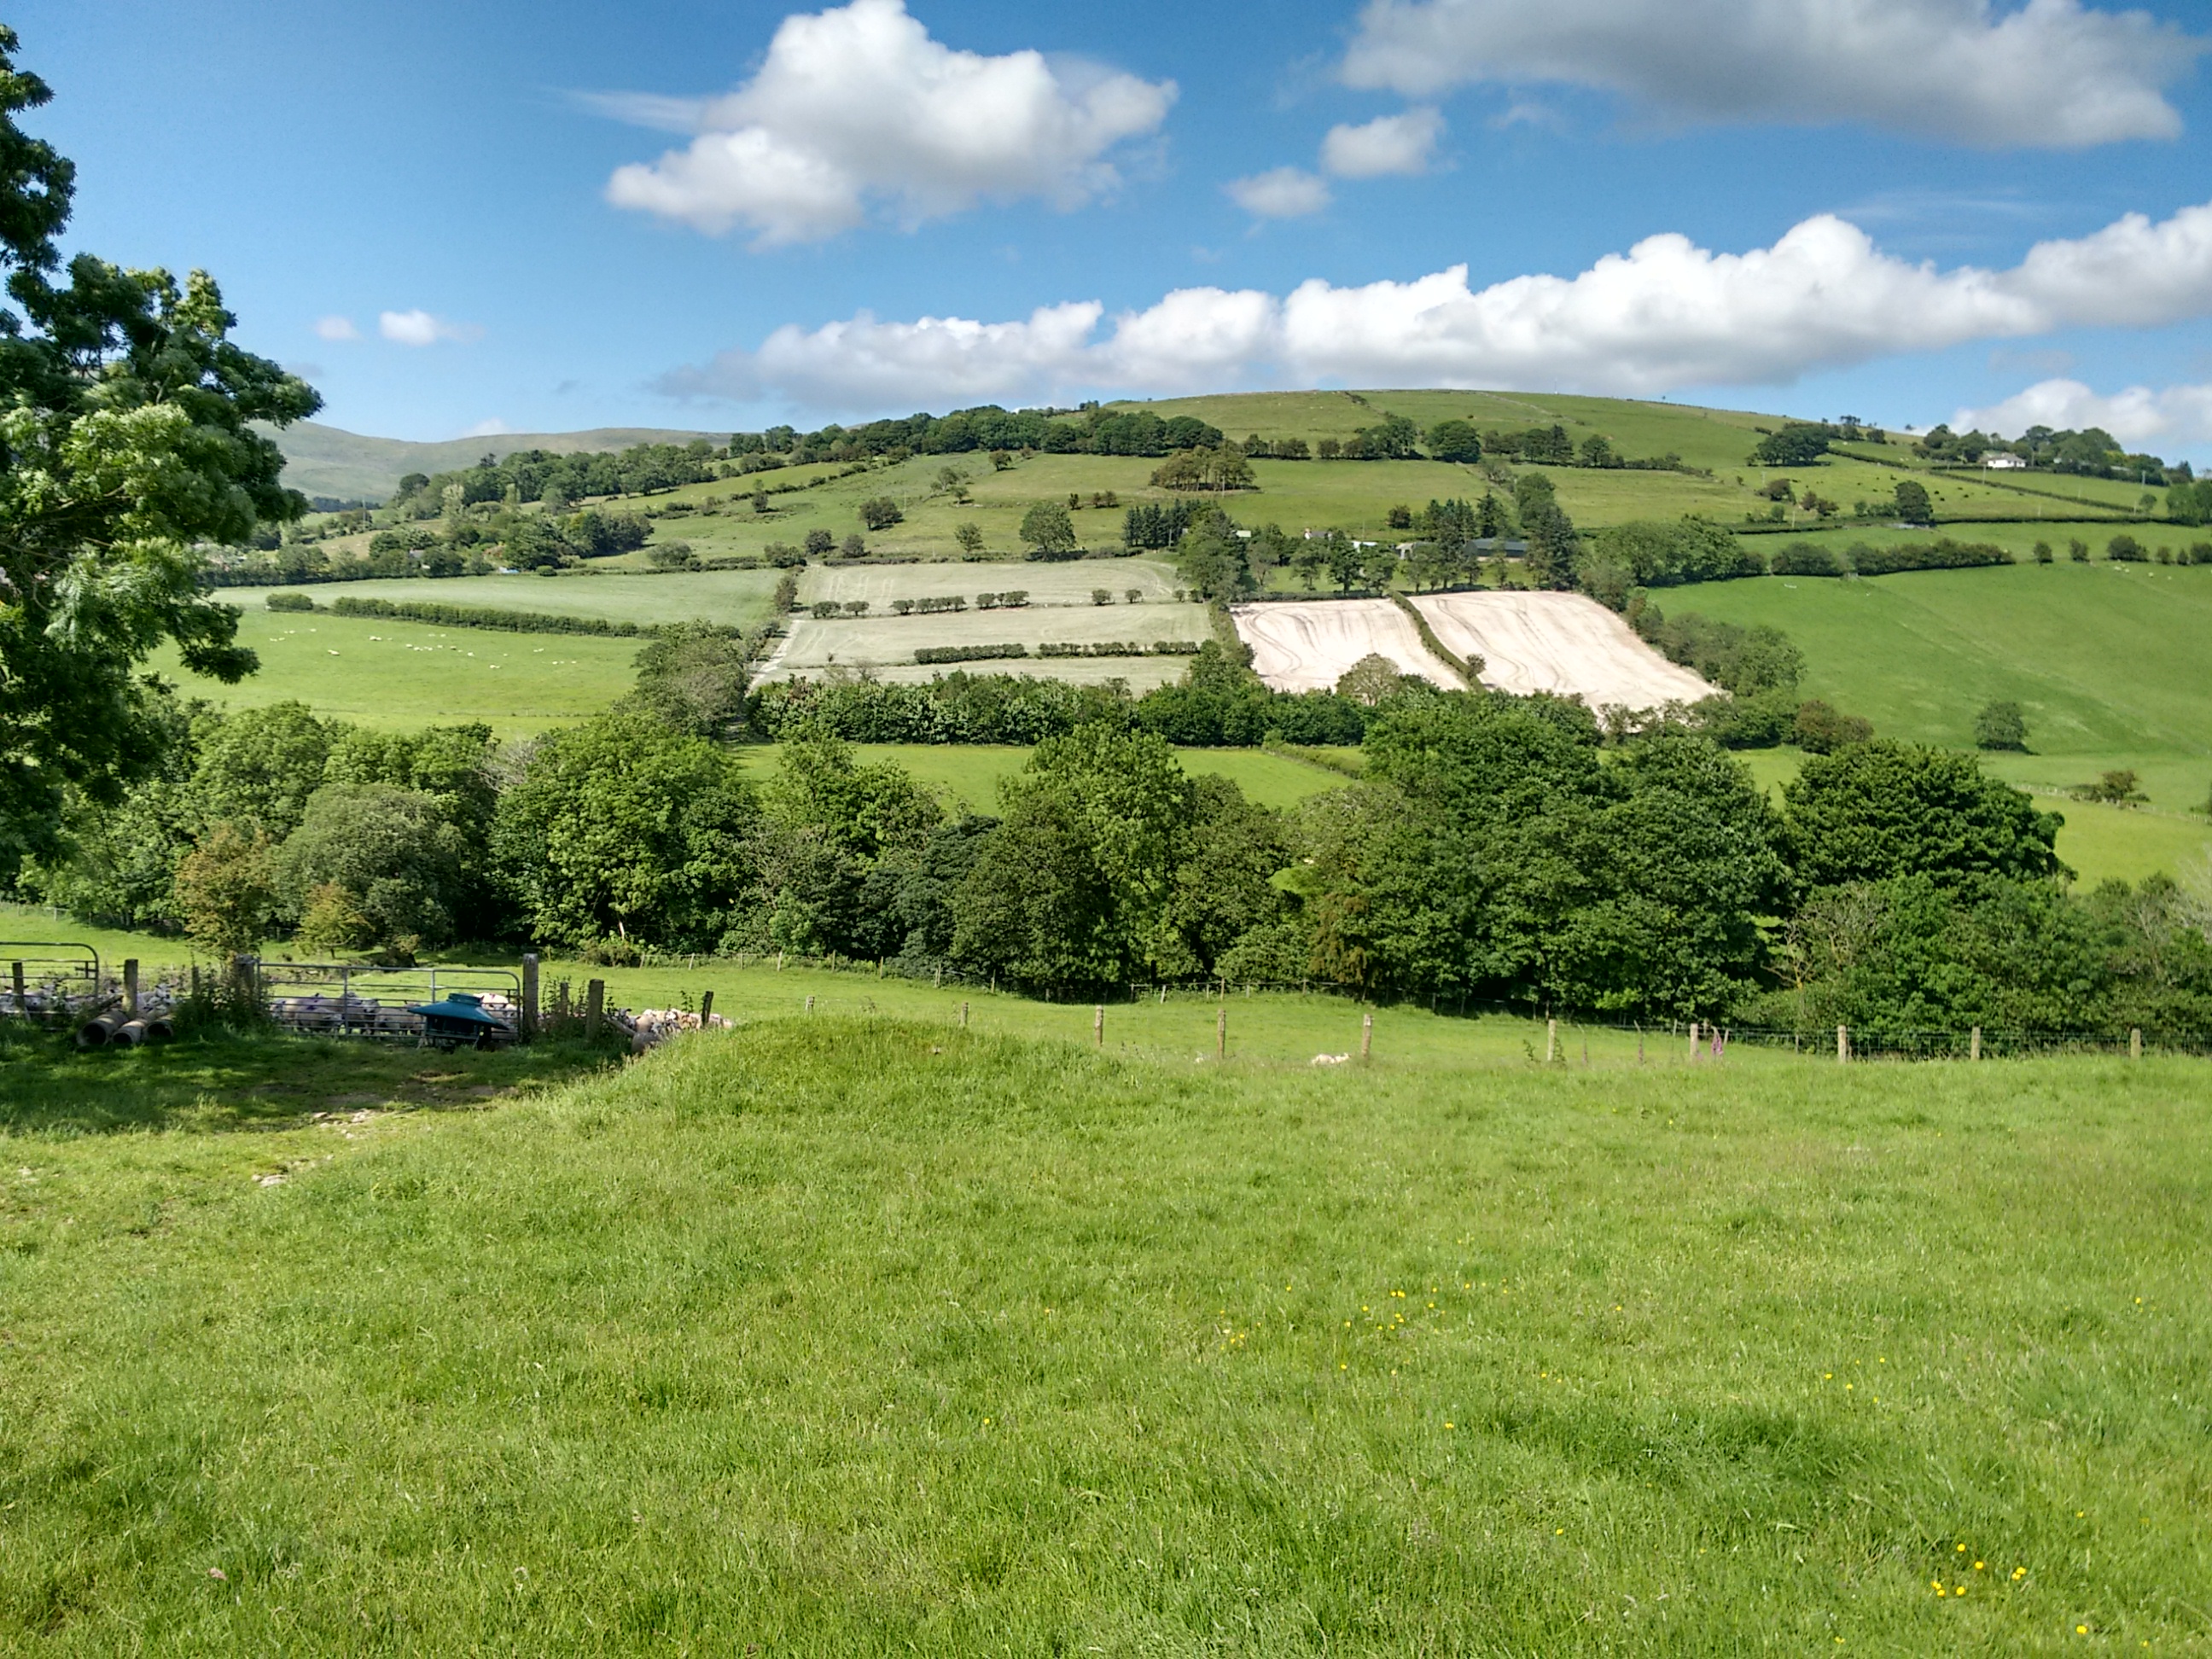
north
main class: Grassland
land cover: Grassland without tree/shrub cover
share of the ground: > 75 %
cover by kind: herbaceous plants 100 %
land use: Agriculture (excluding fallow land and kitchen gardens)
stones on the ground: 25 - 50 %
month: July
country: GB
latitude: 54.7601
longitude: -7.1605
